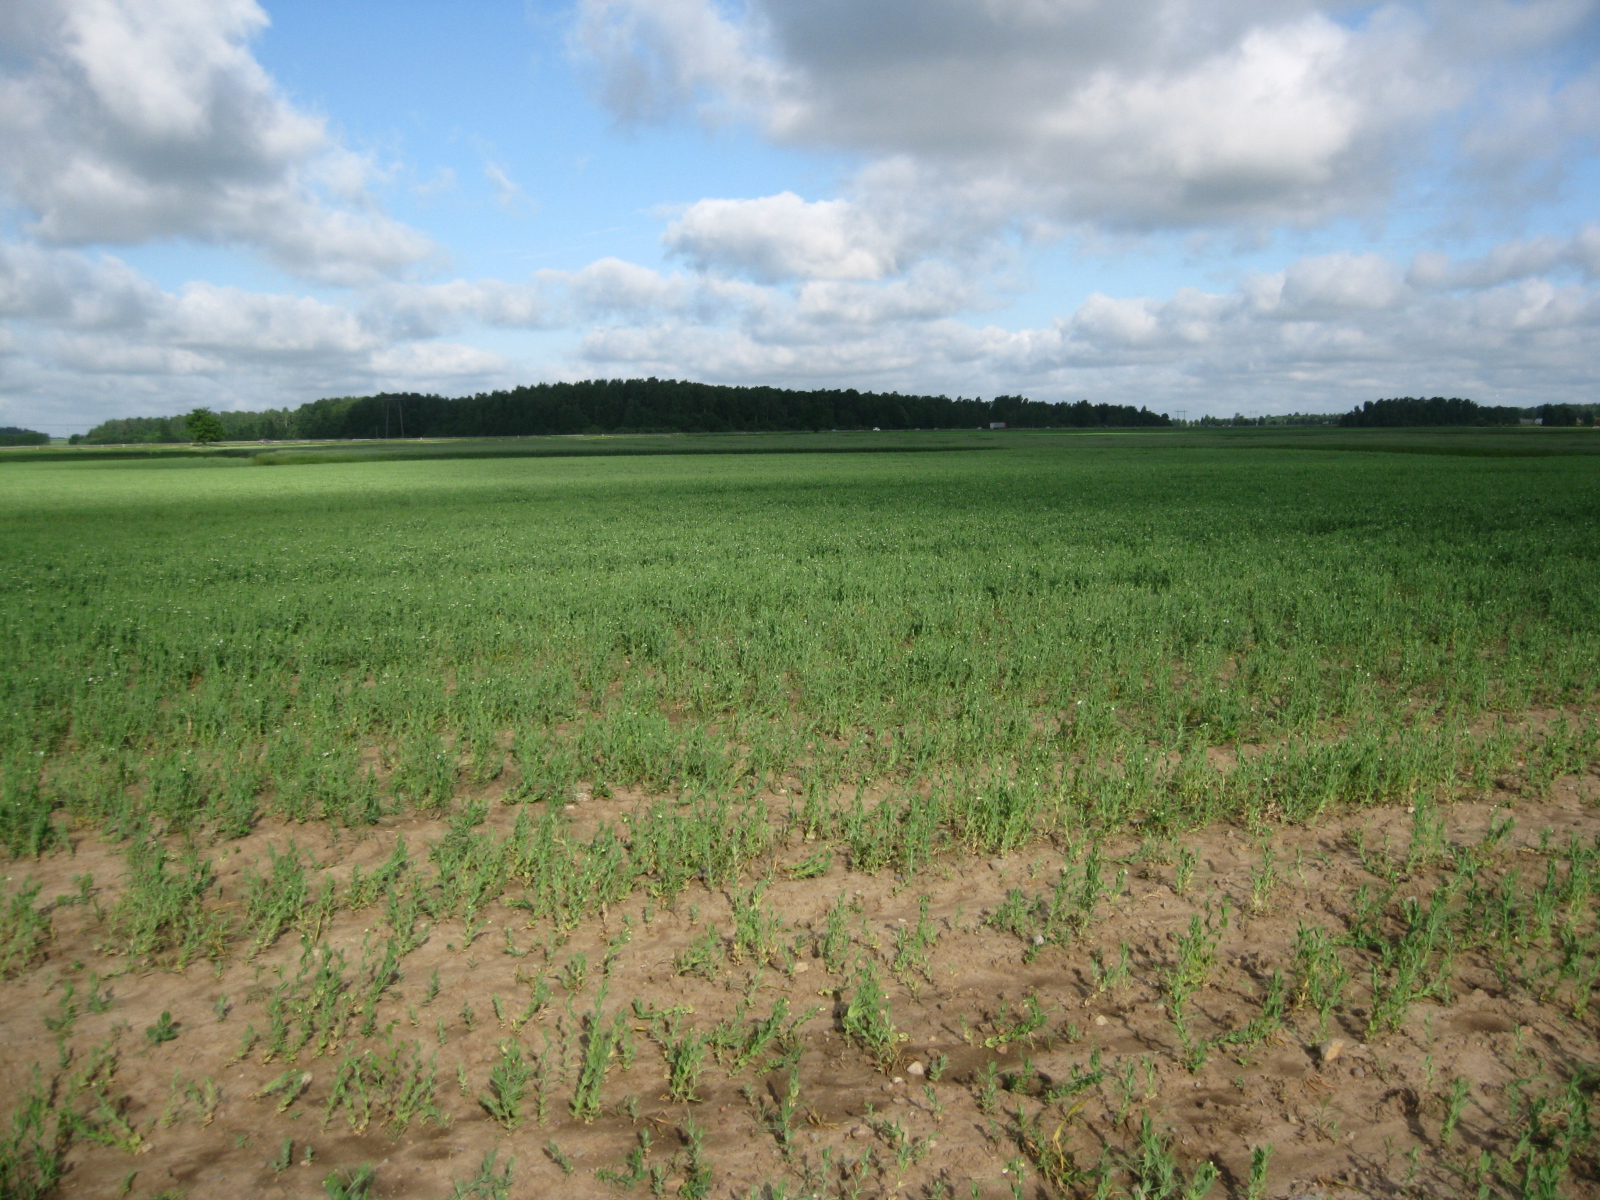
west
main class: Cropland
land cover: Dry pulses
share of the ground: 25 - 50 %
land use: Agriculture (excluding fallow land and kitchen gardens)
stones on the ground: < 10 %
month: June
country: LT
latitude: 55.1780
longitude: 23.6662
